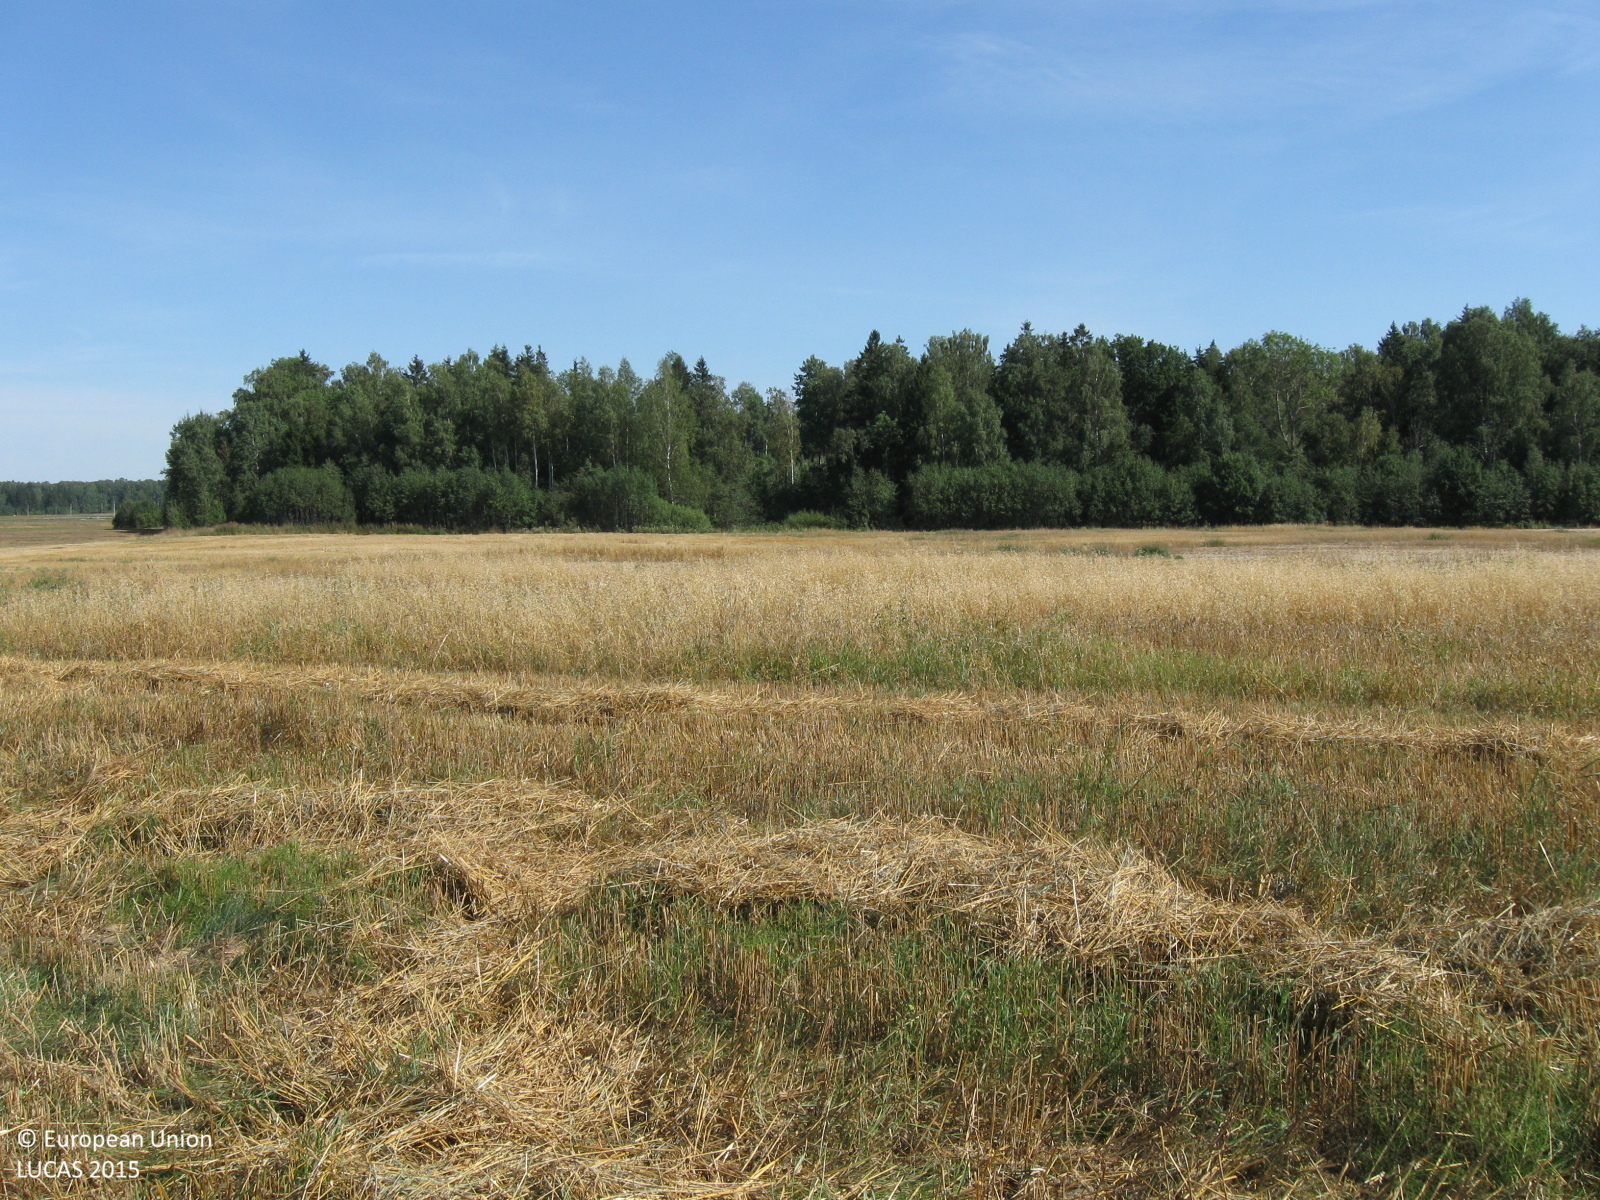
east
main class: Cropland
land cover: Common wheat
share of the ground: > 75 %
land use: Agriculture (excluding fallow land and kitchen gardens)
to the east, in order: Common wheat; Spontaneously vegetated surfaces; Broadleaved woodland
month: August
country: LT
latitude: 55.4537
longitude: 23.3103
